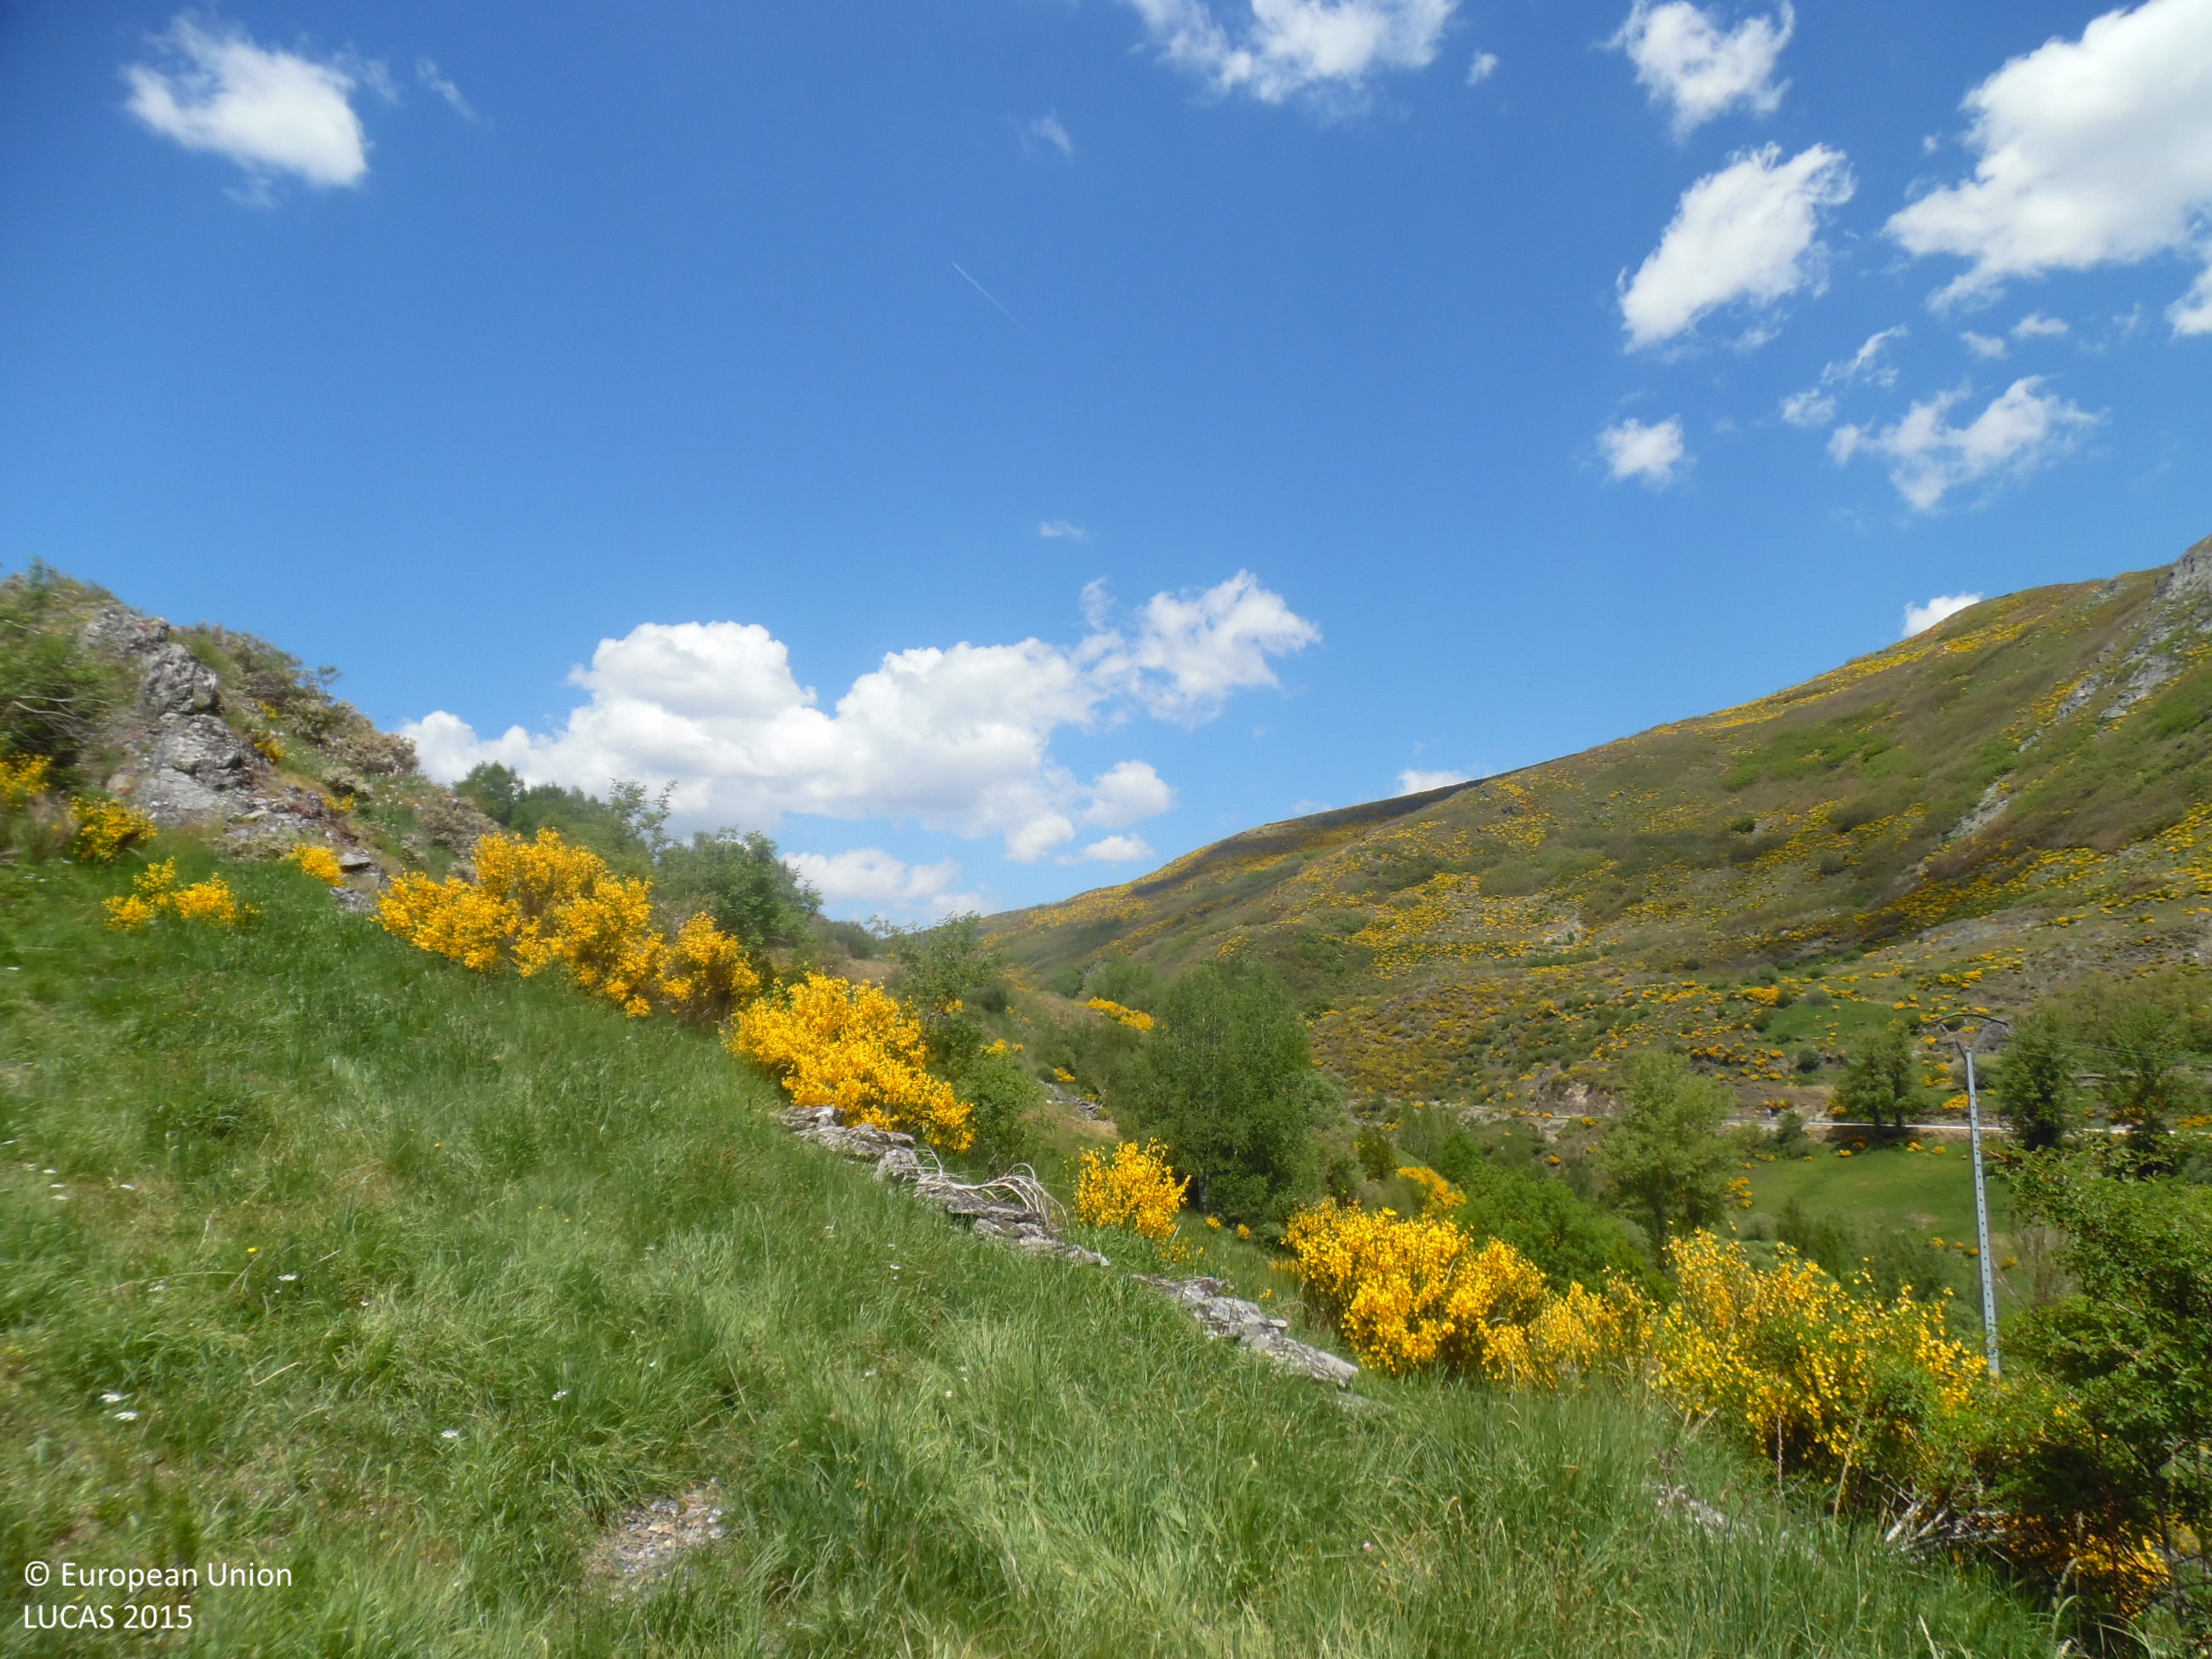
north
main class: Shrubland
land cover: Shrubland with sparse tree cover
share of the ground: > 75 %
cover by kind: shrubs 90 %, broadleaved forest trees 5 %, herbaceous plants 5 %
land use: Agriculture (excluding fallow land and kitchen gardens)
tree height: < 5 m
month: May
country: ES
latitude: 42.8950
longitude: -6.2436
